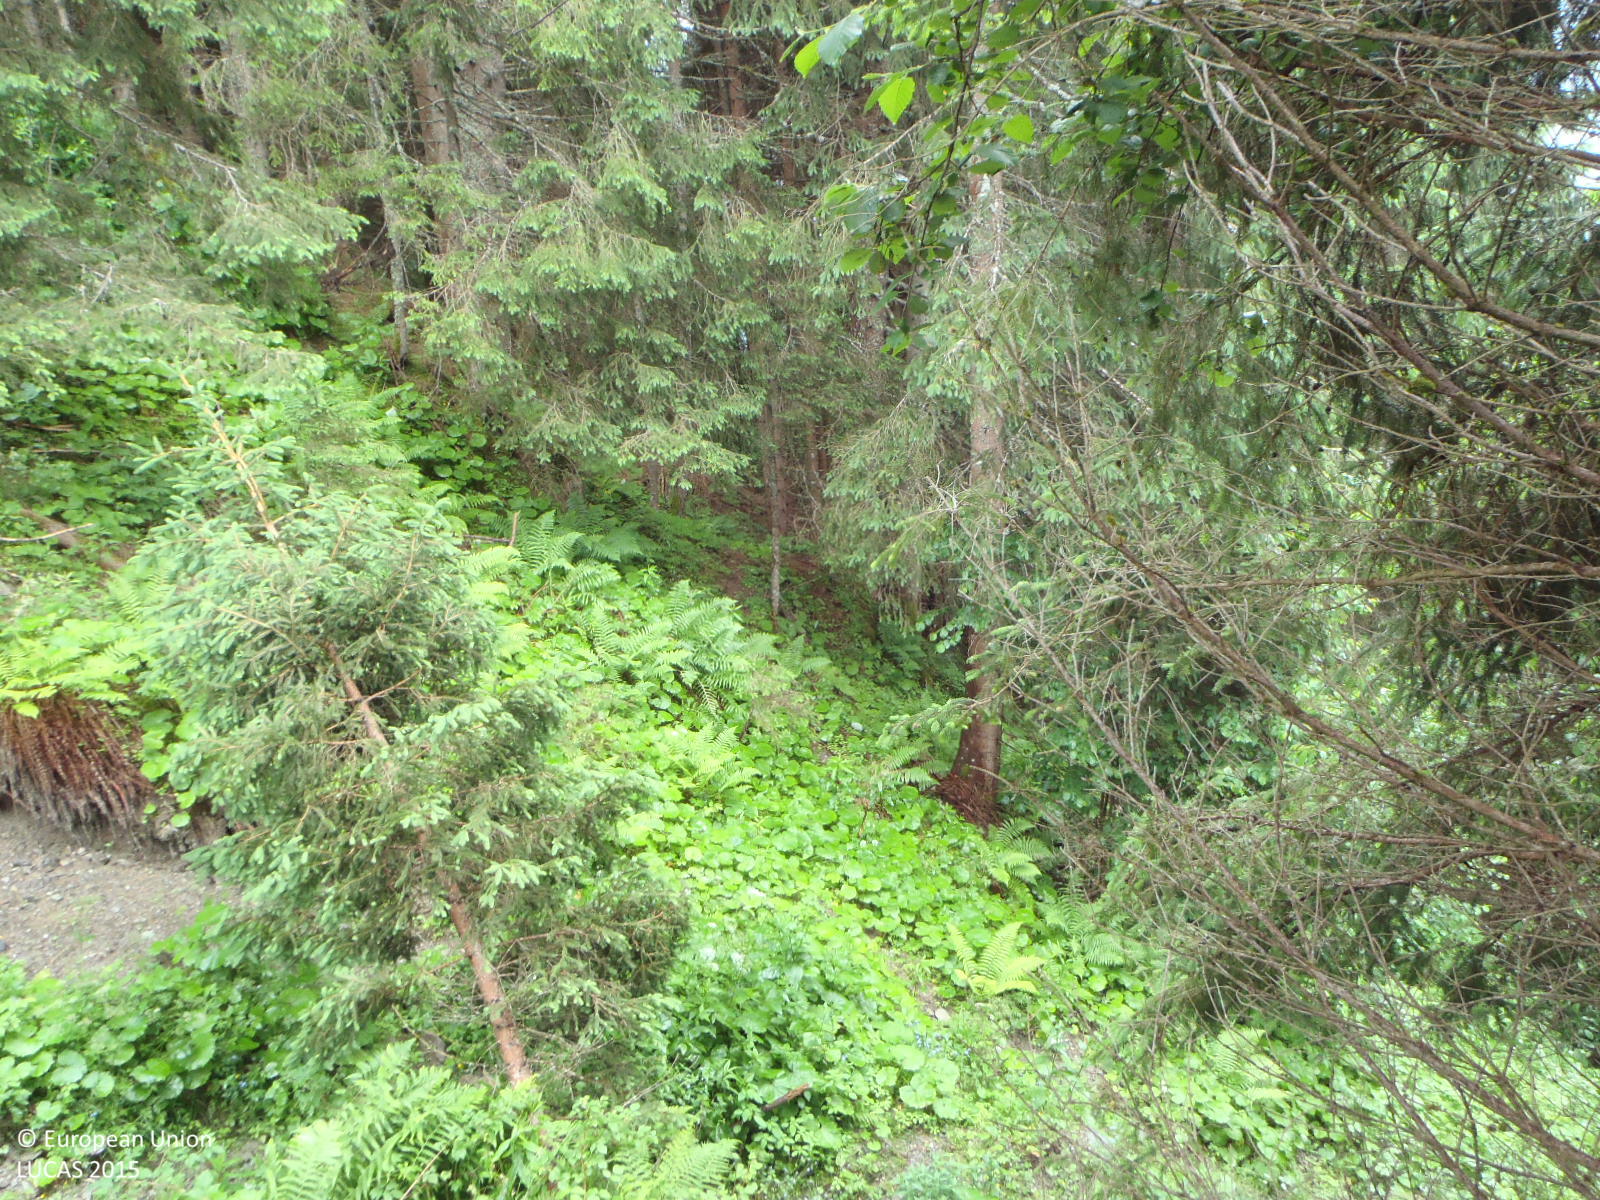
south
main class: Woodland
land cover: Spruce dominated coniferous woodland
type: alpine coniferous forest
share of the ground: > 75 %
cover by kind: coniferous forest trees 65 %, broadleaved forest trees 20 %, herbaceous plants 15 %
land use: Forestry
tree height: > 5 m
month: June
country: AT
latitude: 47.3791
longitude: 12.7399
